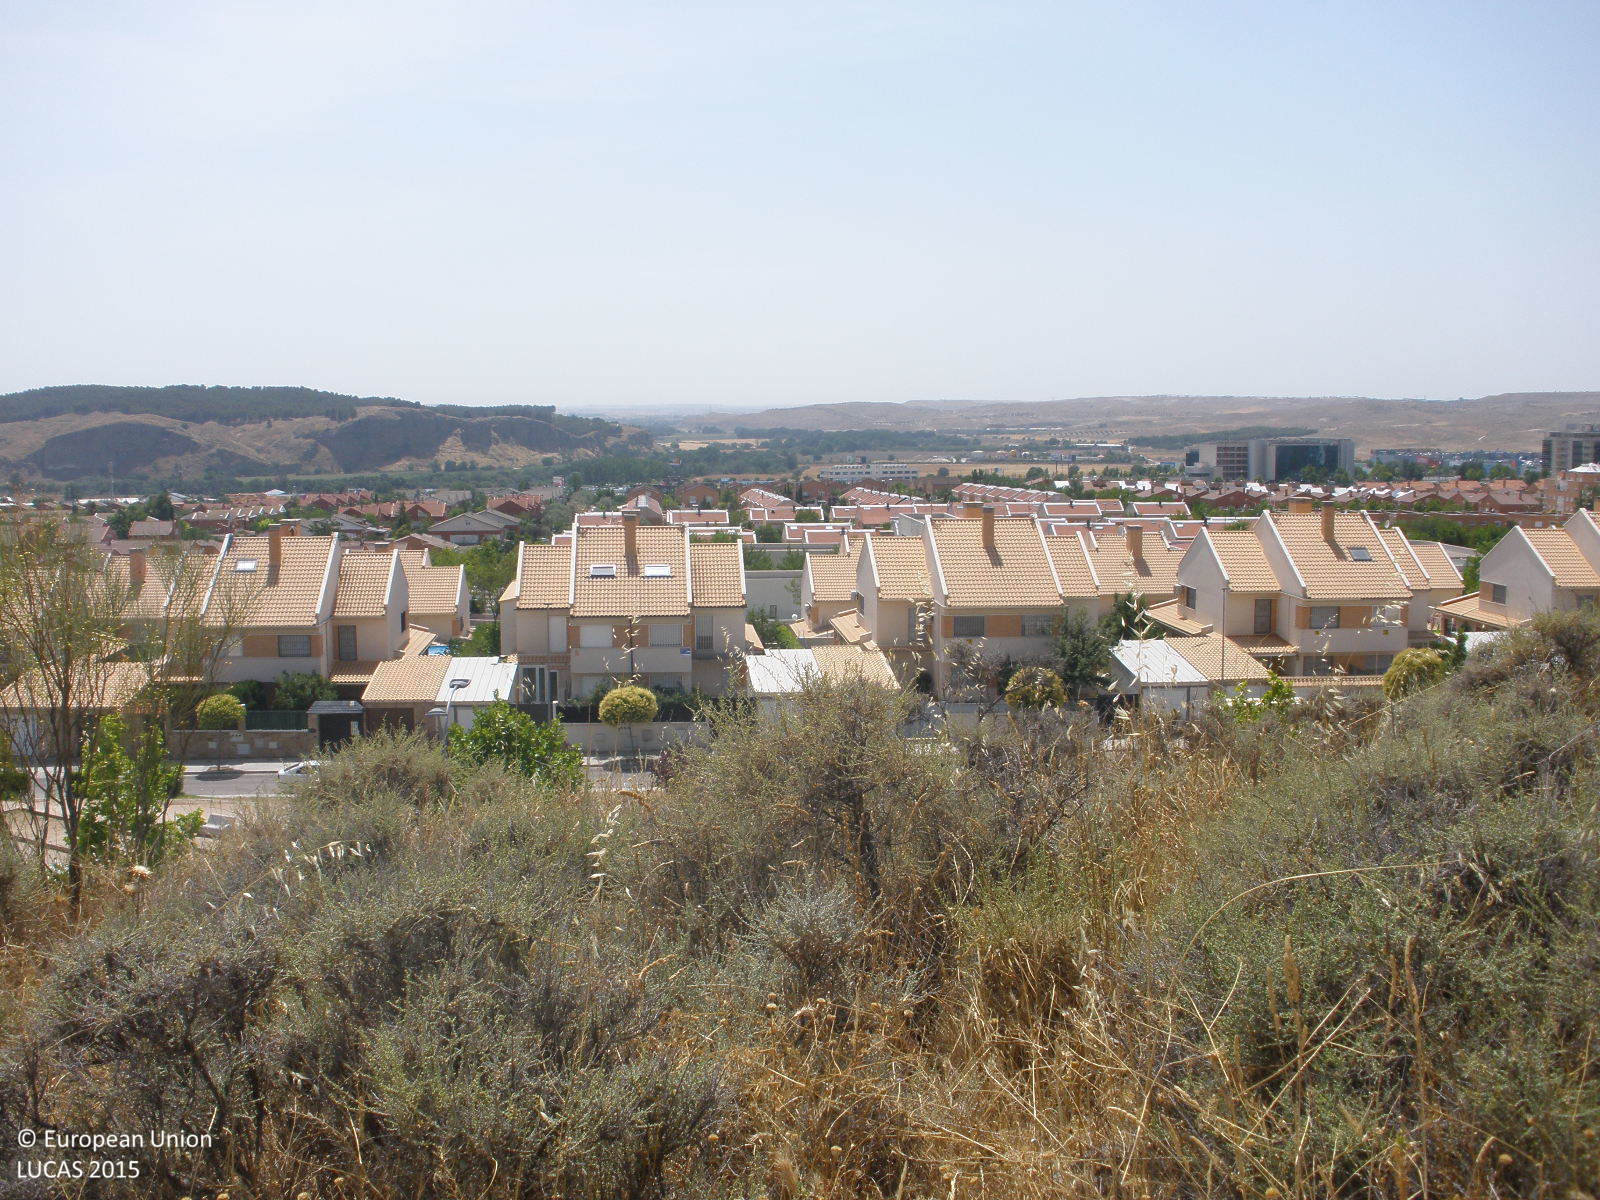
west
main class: Shrubland
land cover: Shrubland without tree cover
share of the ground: 50 - 75 %
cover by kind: shrubs 50 %, herbaceous plants 30 %, consolidated bare surface 20 %
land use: Semi-natural and natural areas not in use
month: July
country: ES
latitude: 40.3351
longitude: -3.5118
